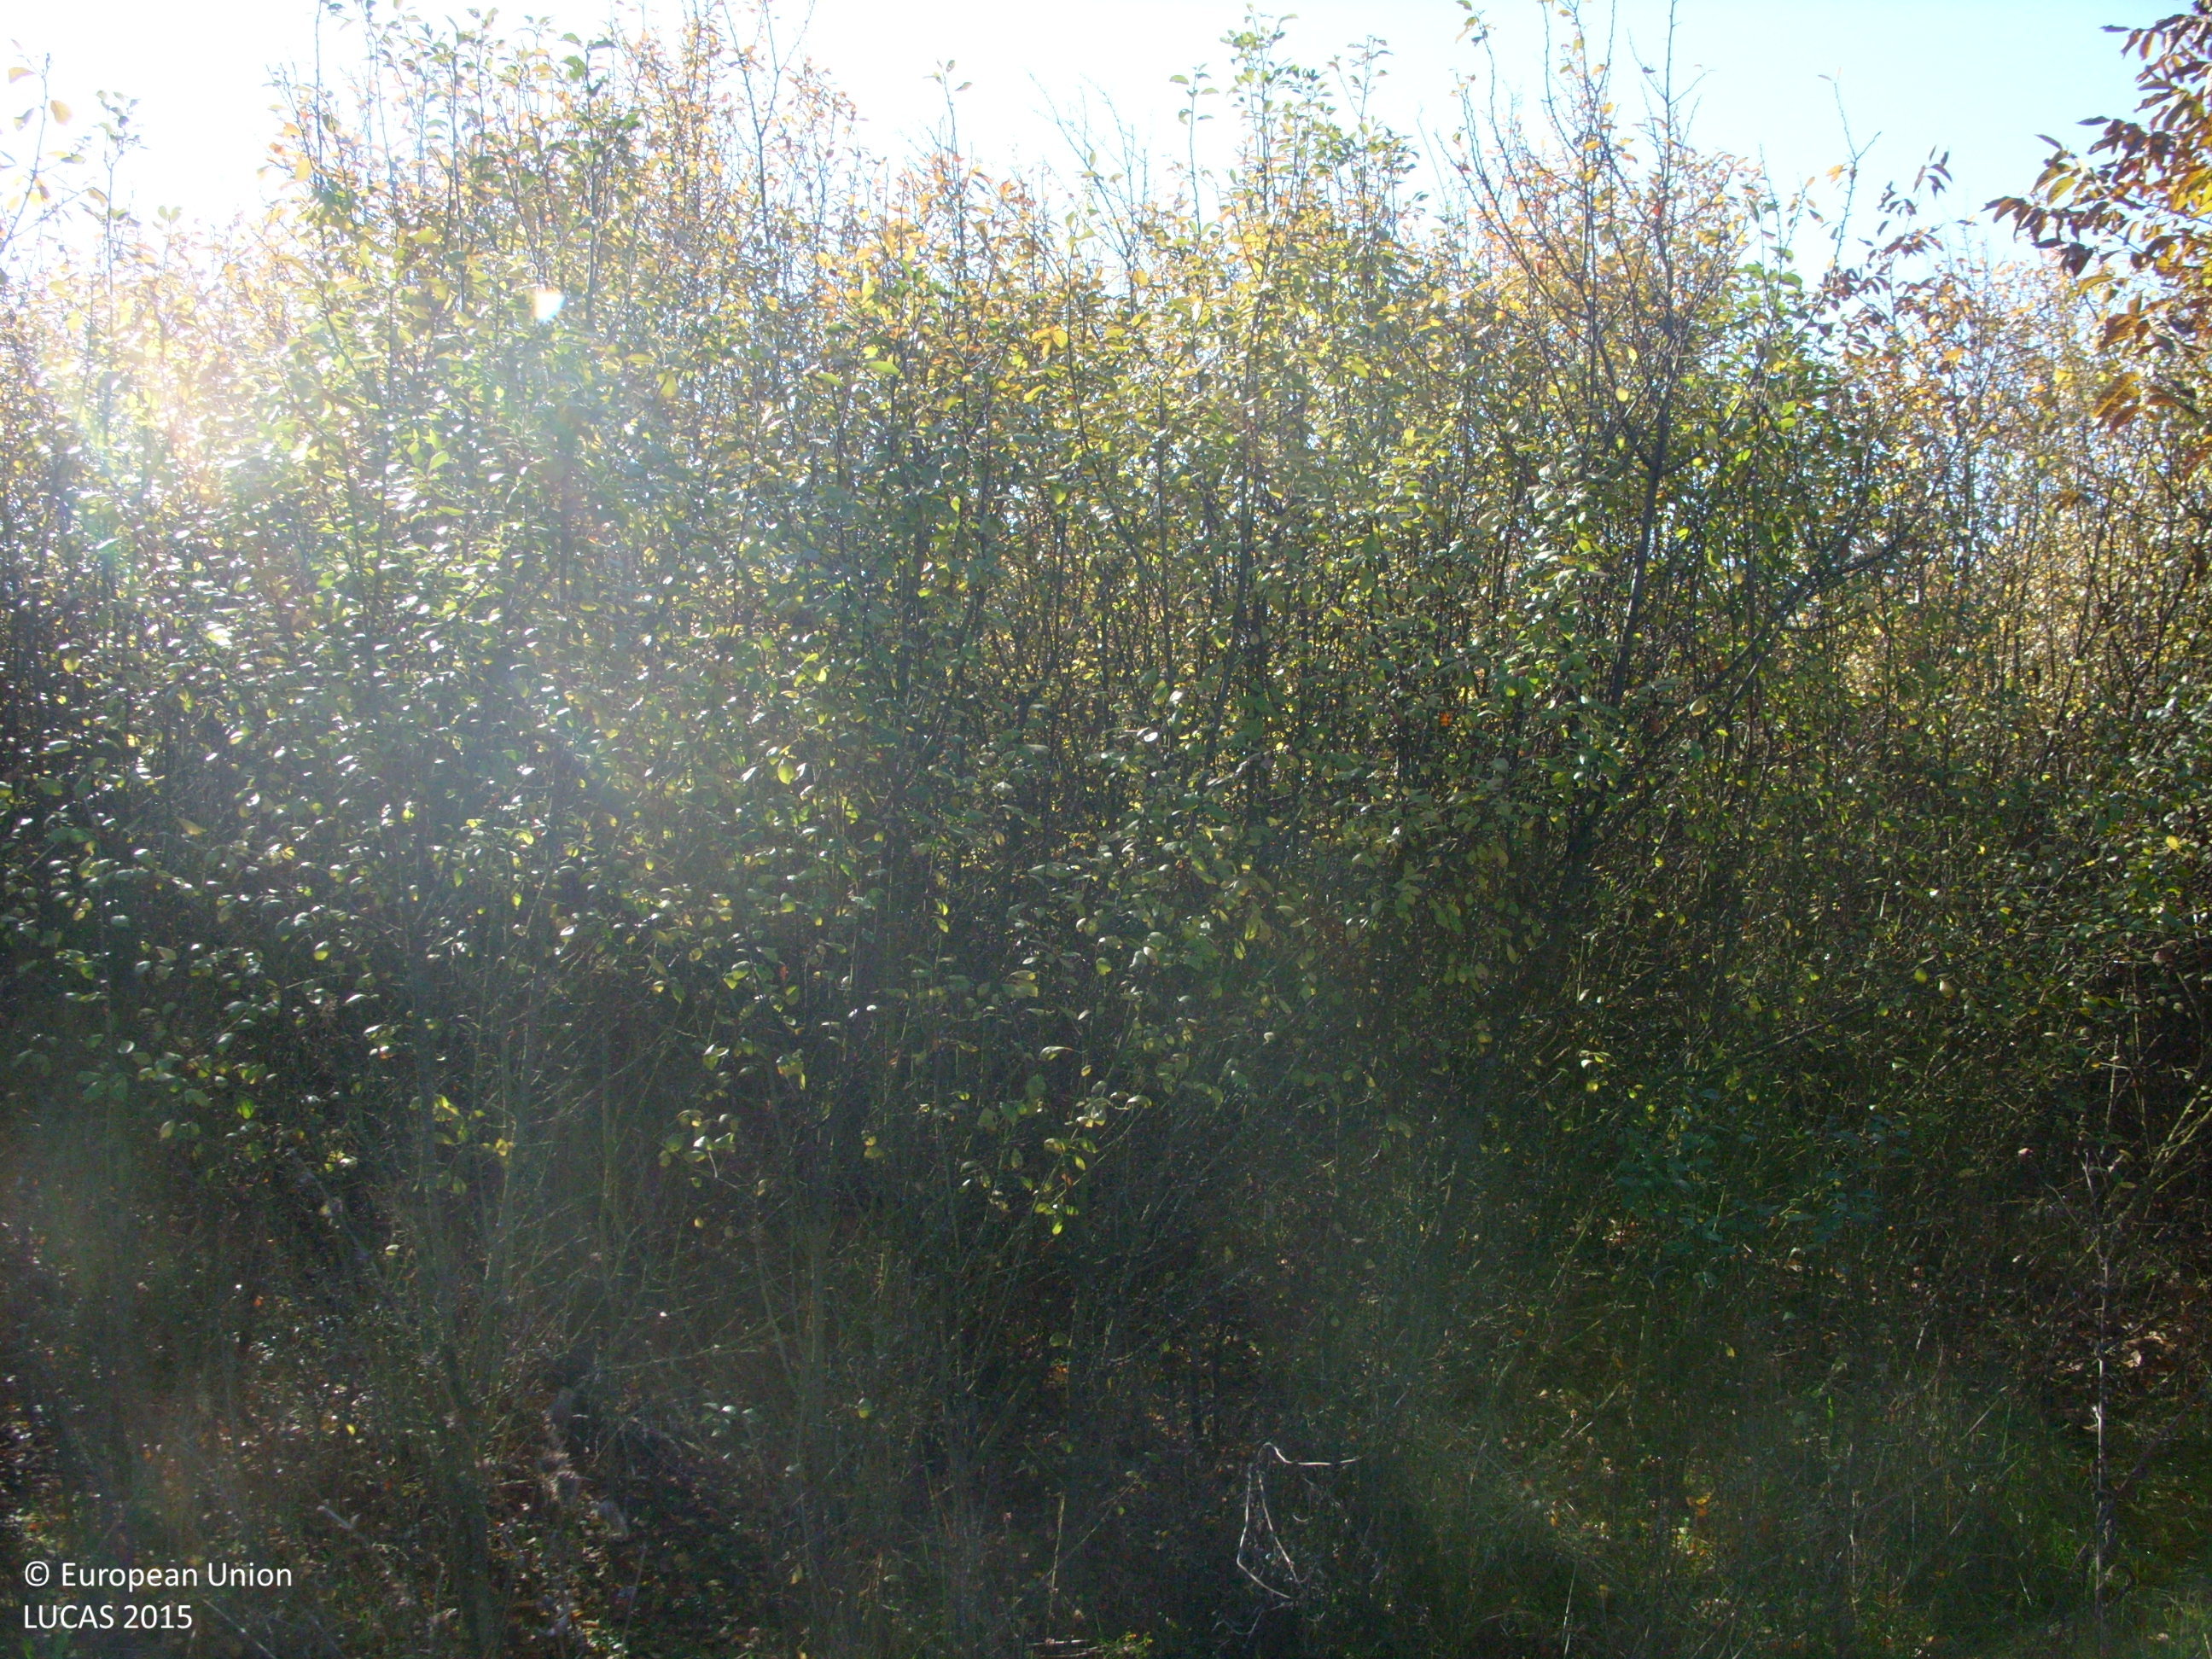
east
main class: Shrubland
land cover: Shrubland with sparse tree cover
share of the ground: > 75 %
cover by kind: shrubs 80 %, herbaceous plants 15 %, broadleaved forest trees 5 %
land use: Abandoned areas
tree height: < 5 m
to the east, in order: Shrubland with sparse tree cover; Grassland with sparse tree/shrub cover; Other fruit trees and berries
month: November
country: BG
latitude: 42.3226
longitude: 24.9706
